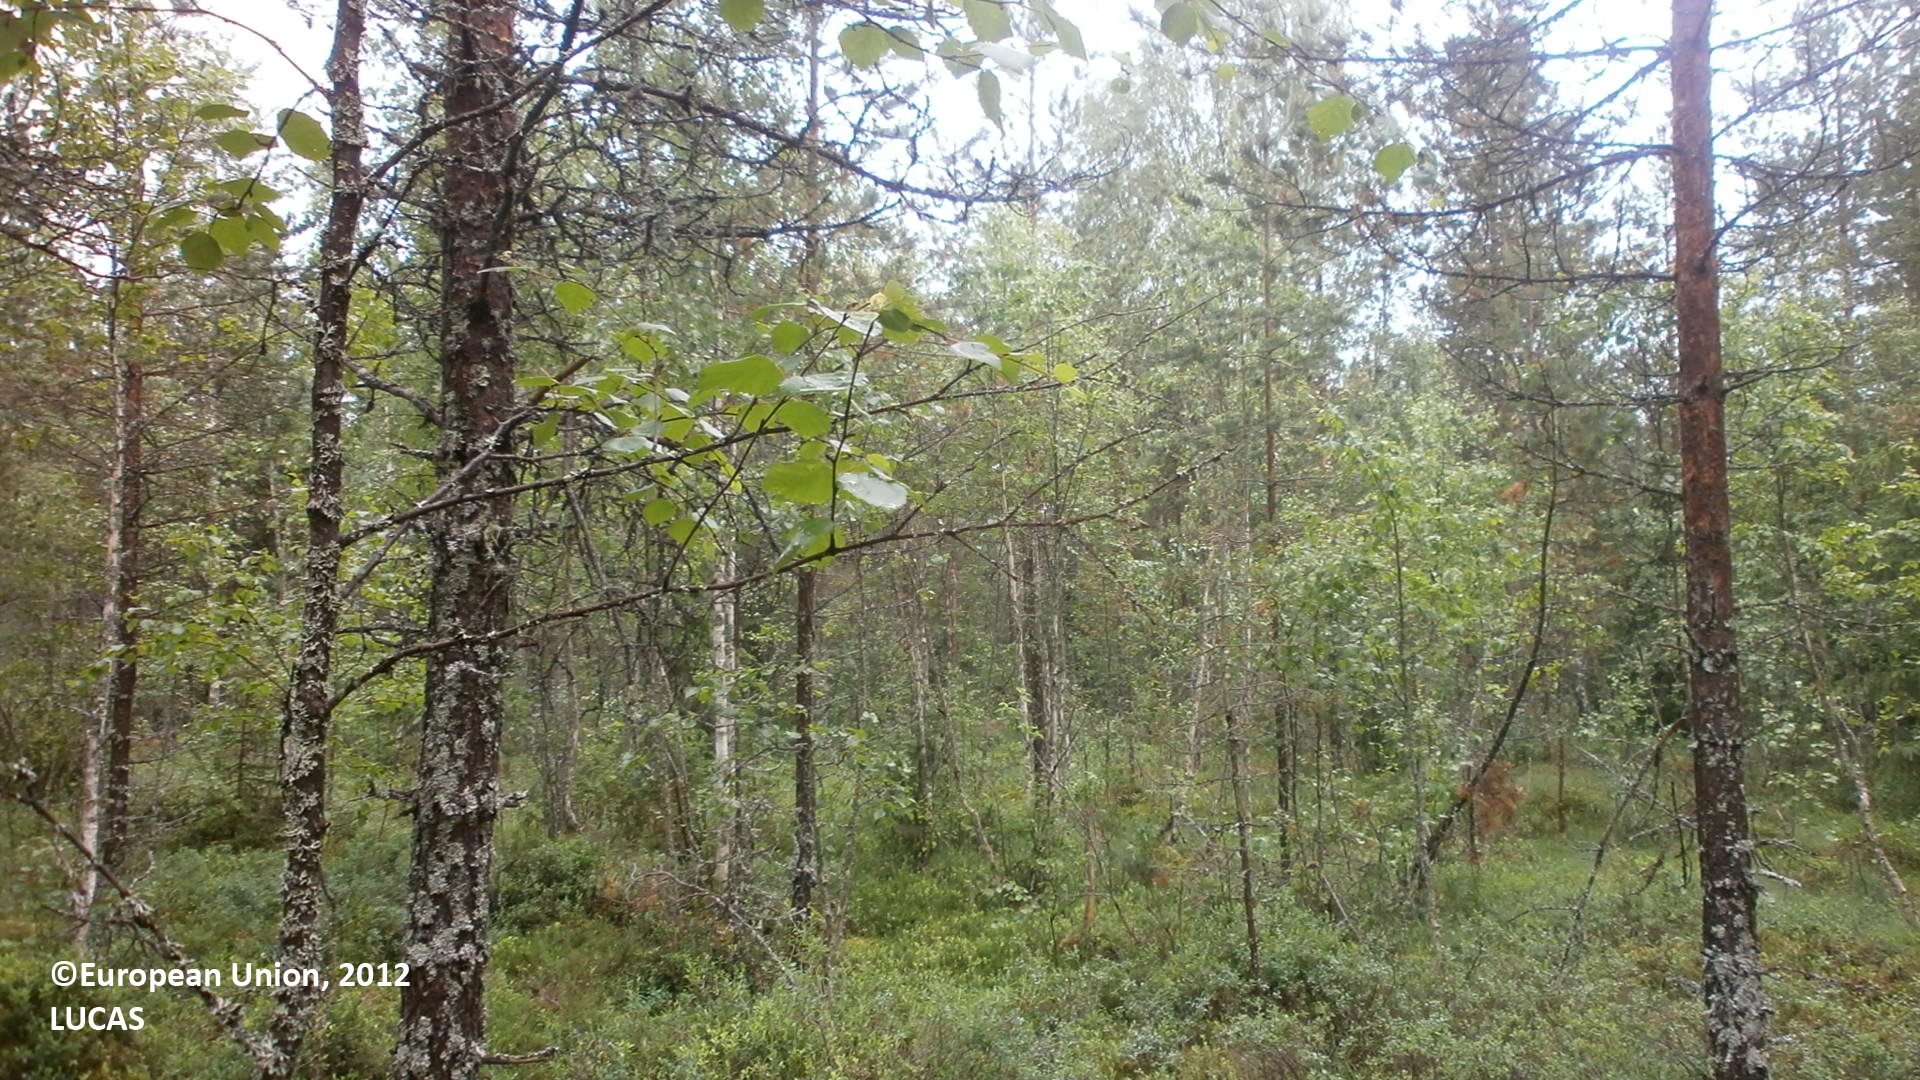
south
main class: Woodland
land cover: Pine dominated mixed woodland
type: boreal forest
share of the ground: 50 - 75 %
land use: Forestry
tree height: > 5 m
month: July
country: FI
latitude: 64.3862
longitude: 24.9443
